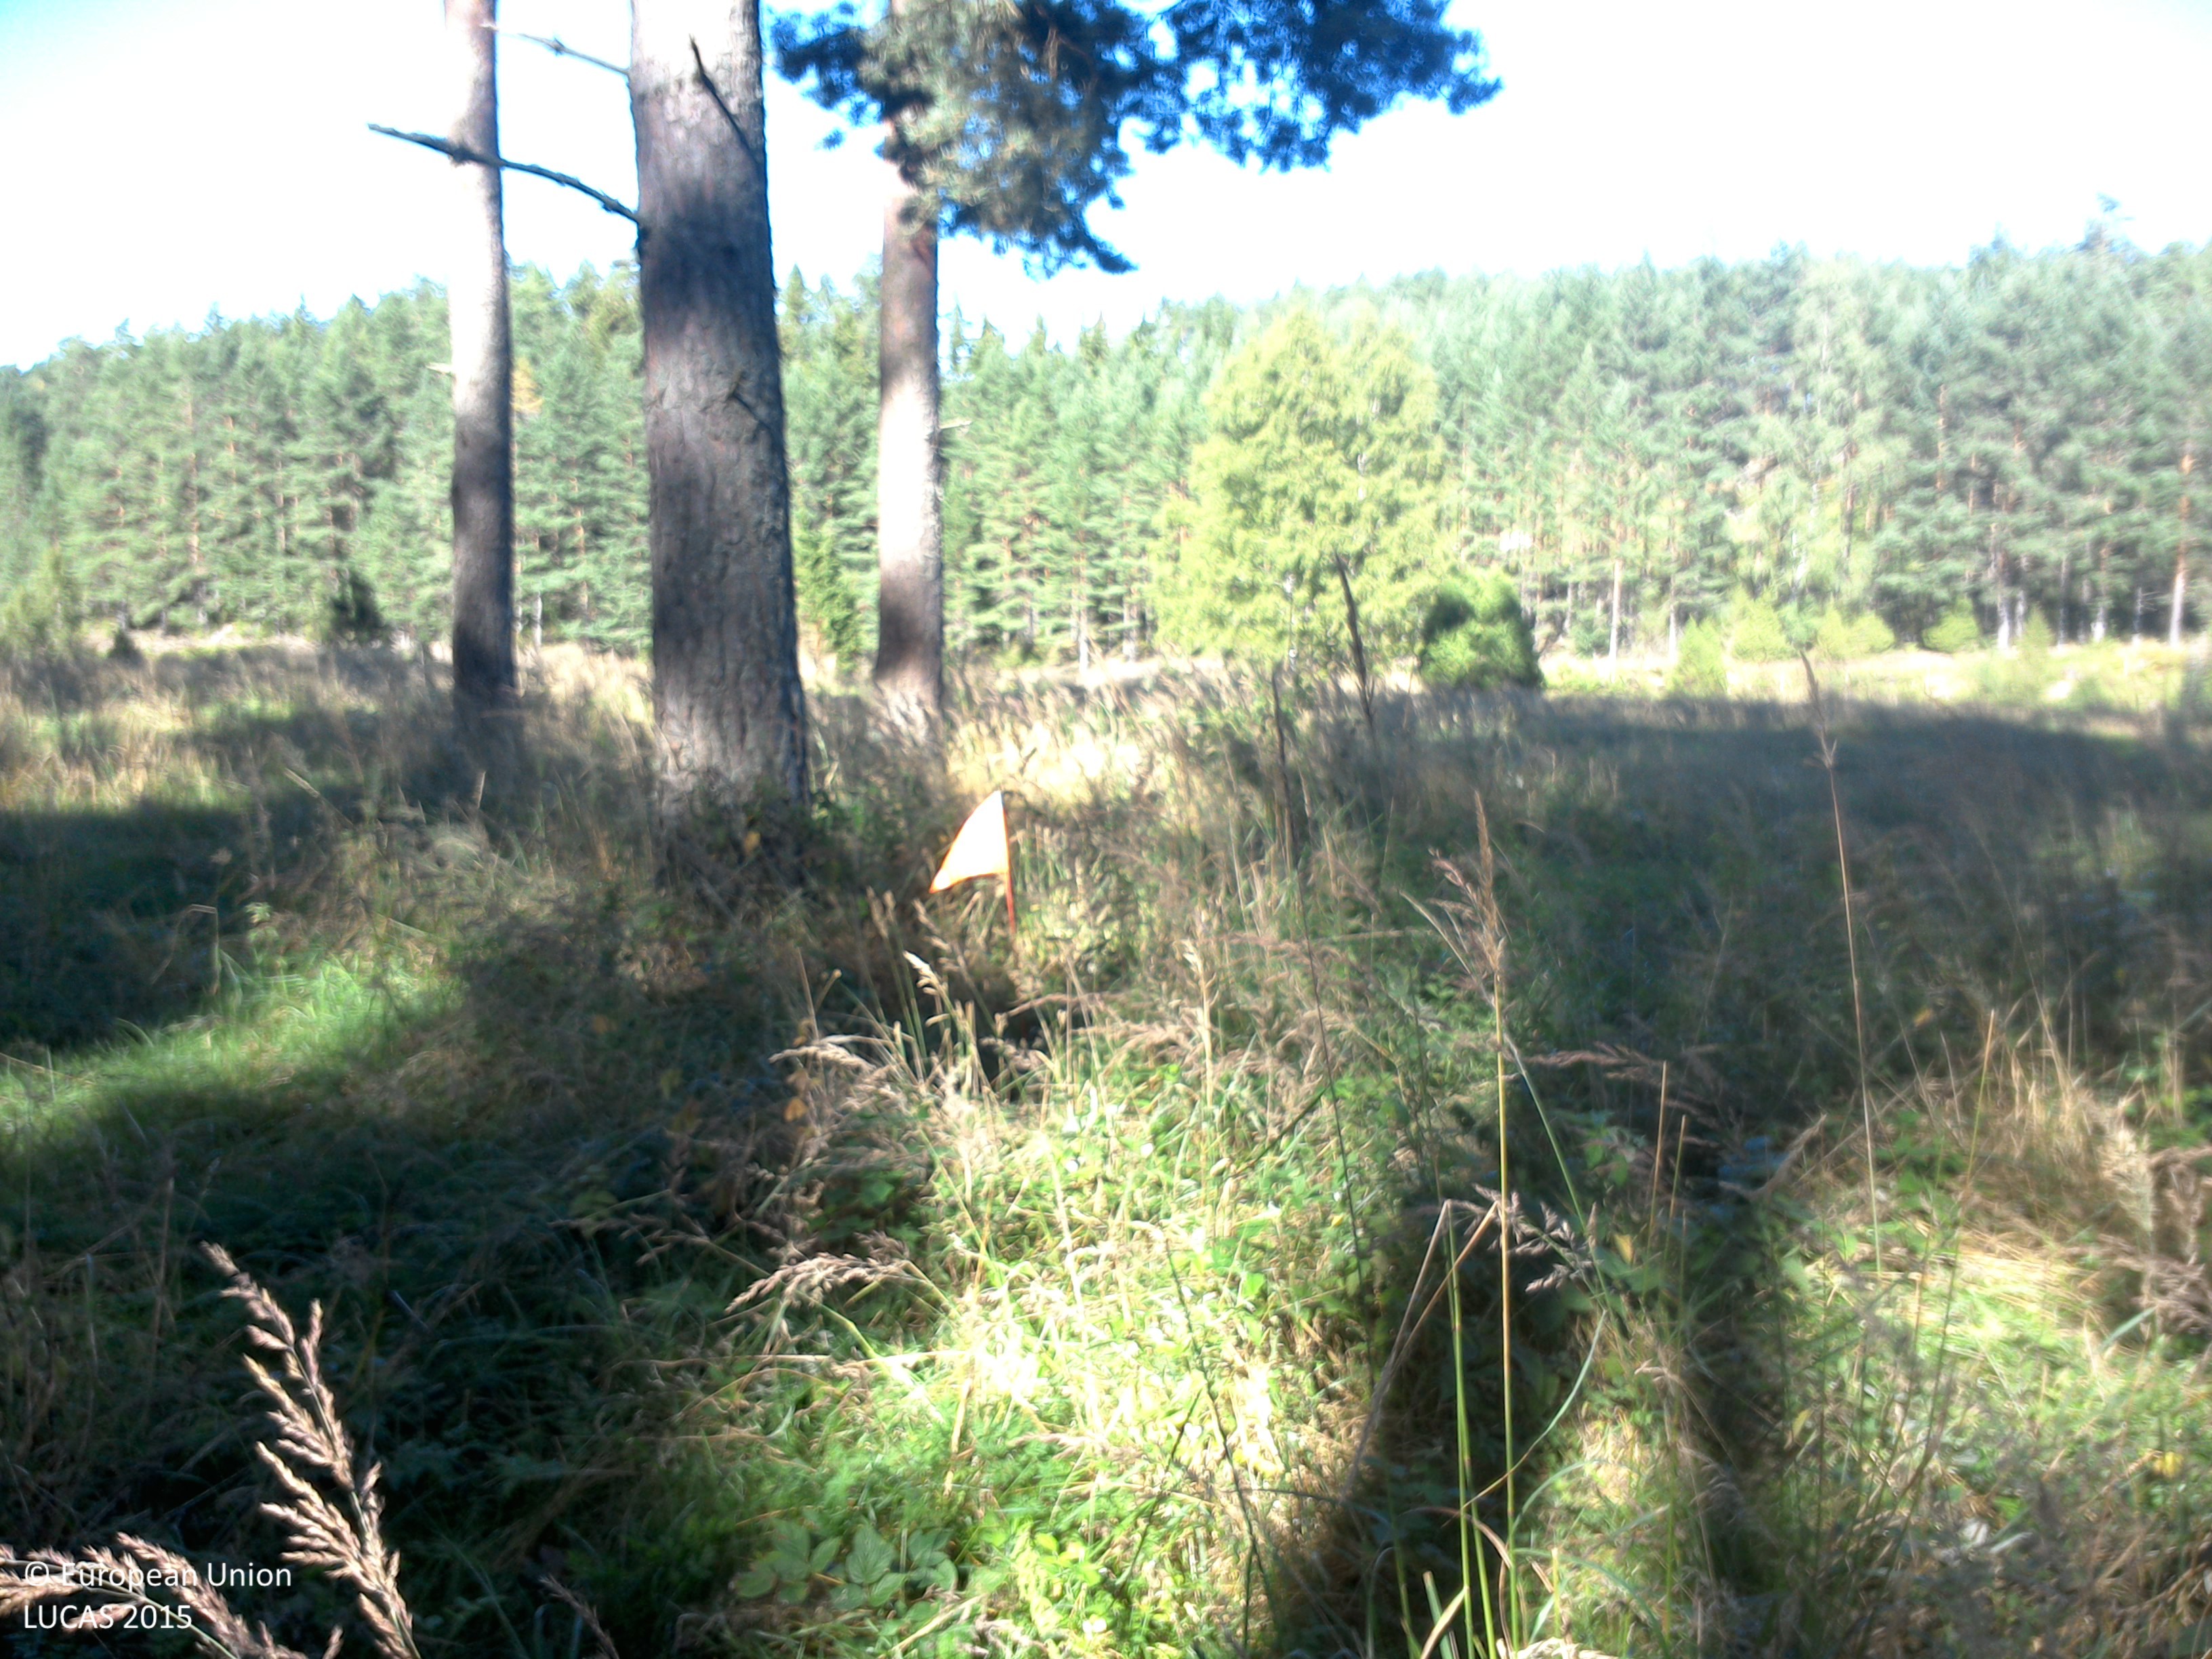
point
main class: Woodland
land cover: Pine dominated coniferous woodland
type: boreal forest
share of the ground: 50 - 75 %
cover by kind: coniferous forest trees 60 %, herbaceous plants 40 %
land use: Agriculture (excluding fallow land and kitchen gardens)
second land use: Forestry
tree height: > 5 m
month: August
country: SE
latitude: 58.0816
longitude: 15.2349
